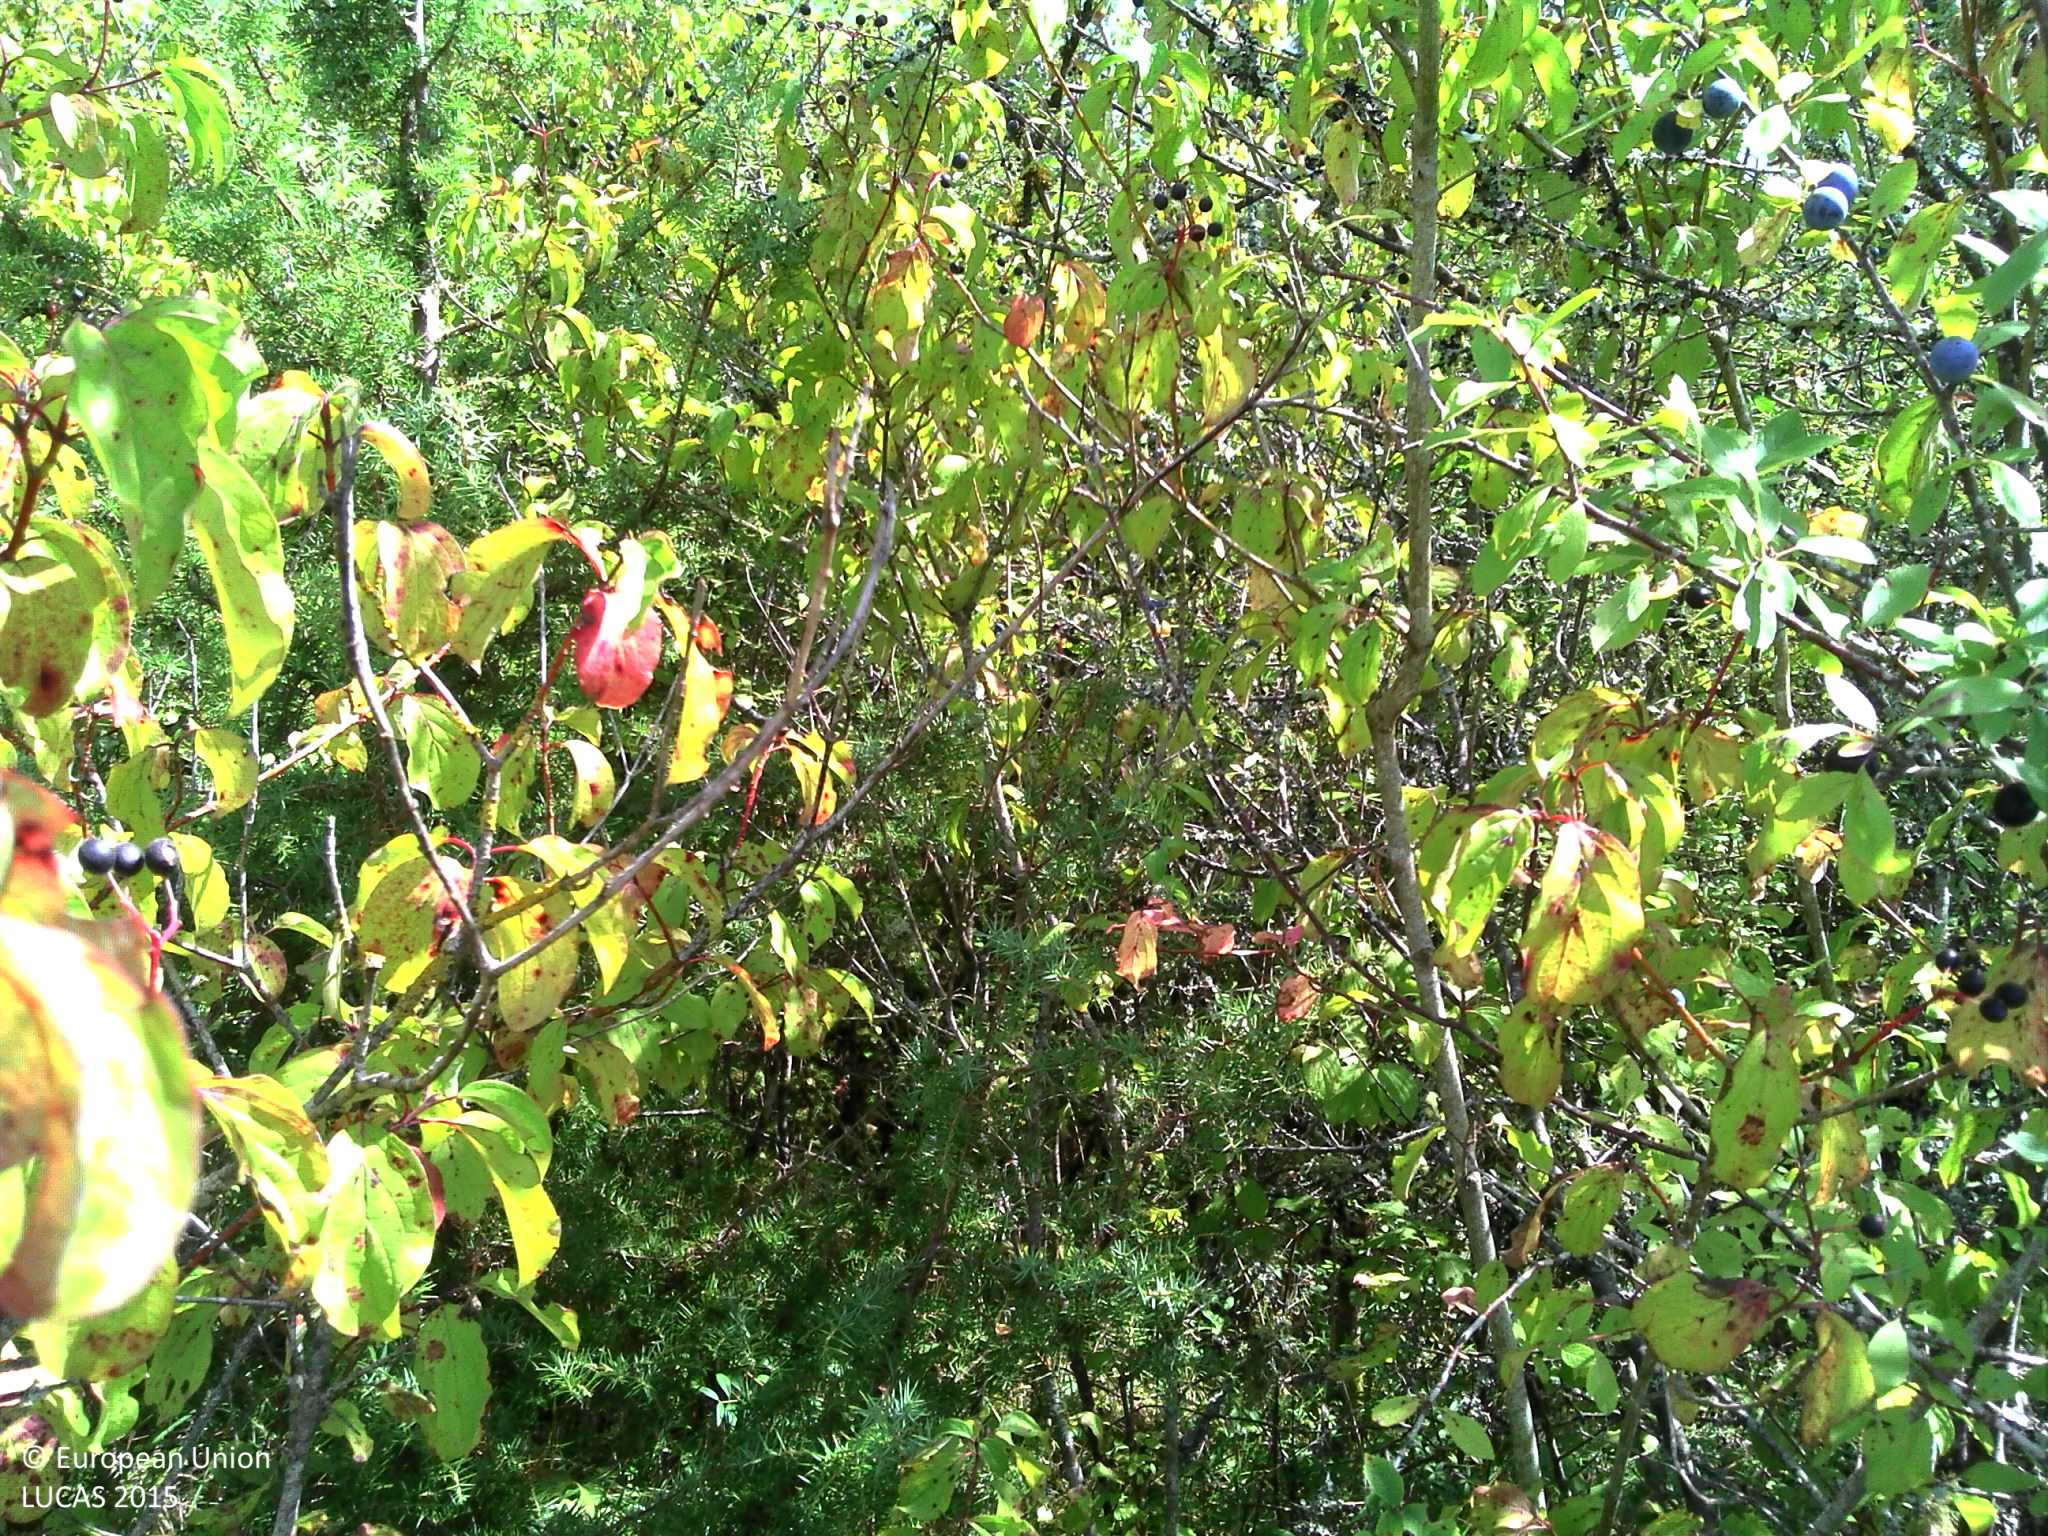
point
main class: Shrubland
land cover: Shrubland with sparse tree cover
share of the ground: > 75 %
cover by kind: shrubs 45 %, herbaceous plants 40 %, lichens and mosses 10 %, broadleaved forest trees 5 %
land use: Forestry
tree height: < 5 m
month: August
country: FR
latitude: 45.2025
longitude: 0.5041
